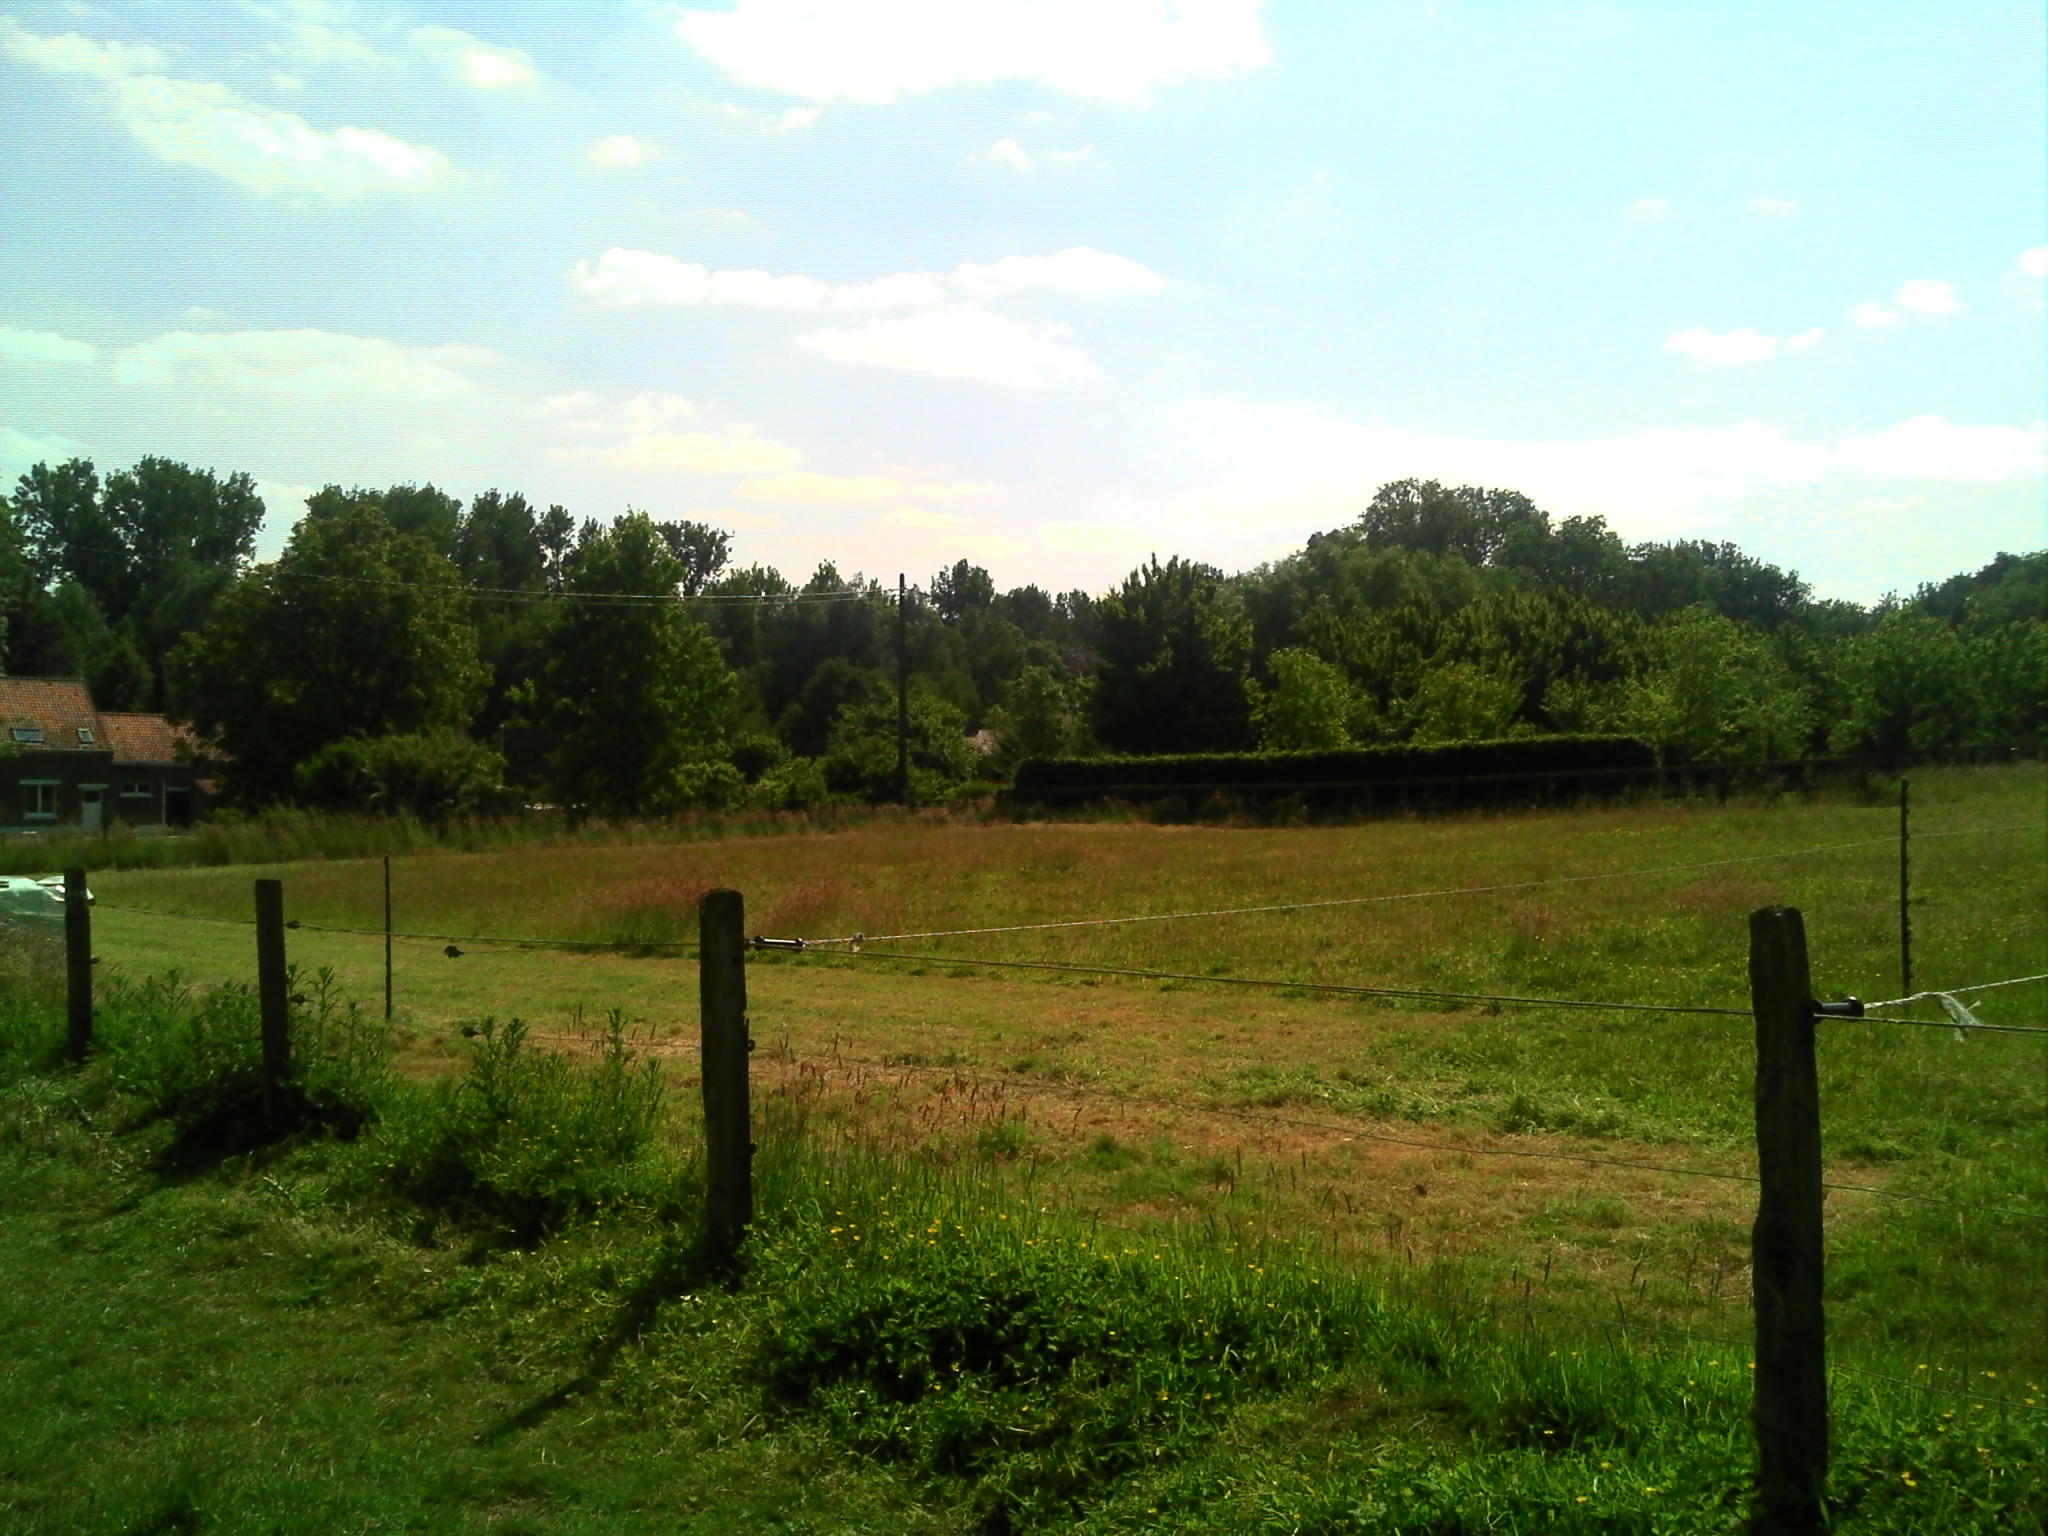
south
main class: Grassland
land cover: Grassland without tree/shrub cover
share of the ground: > 75 %
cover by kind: herbaceous plants 100 %
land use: Agriculture (excluding fallow land and kitchen gardens)
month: June
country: BE
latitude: 50.9245
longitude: 4.2903
